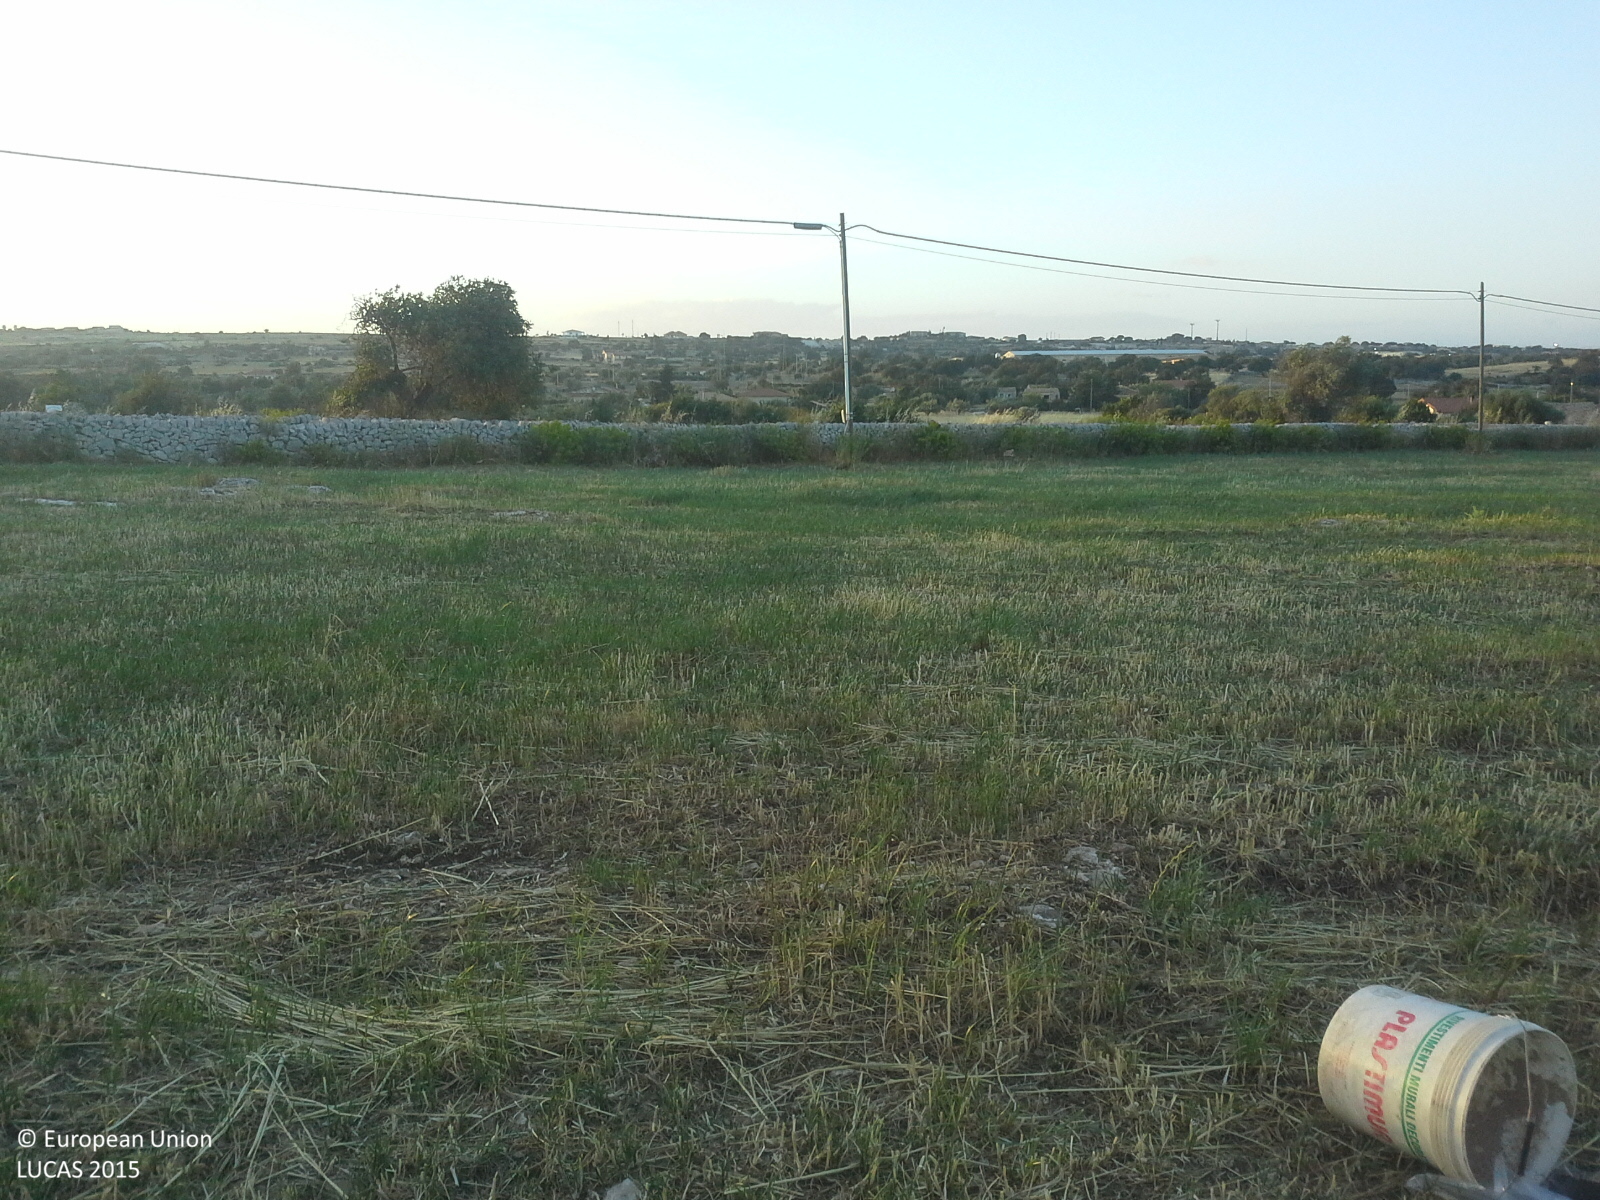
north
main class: Cropland
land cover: Mixed cereals for fodder
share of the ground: > 75 %
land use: Agriculture (excluding fallow land and kitchen gardens)
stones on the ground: < 10 %
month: May
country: IT
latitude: 36.7888
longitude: 14.8134
